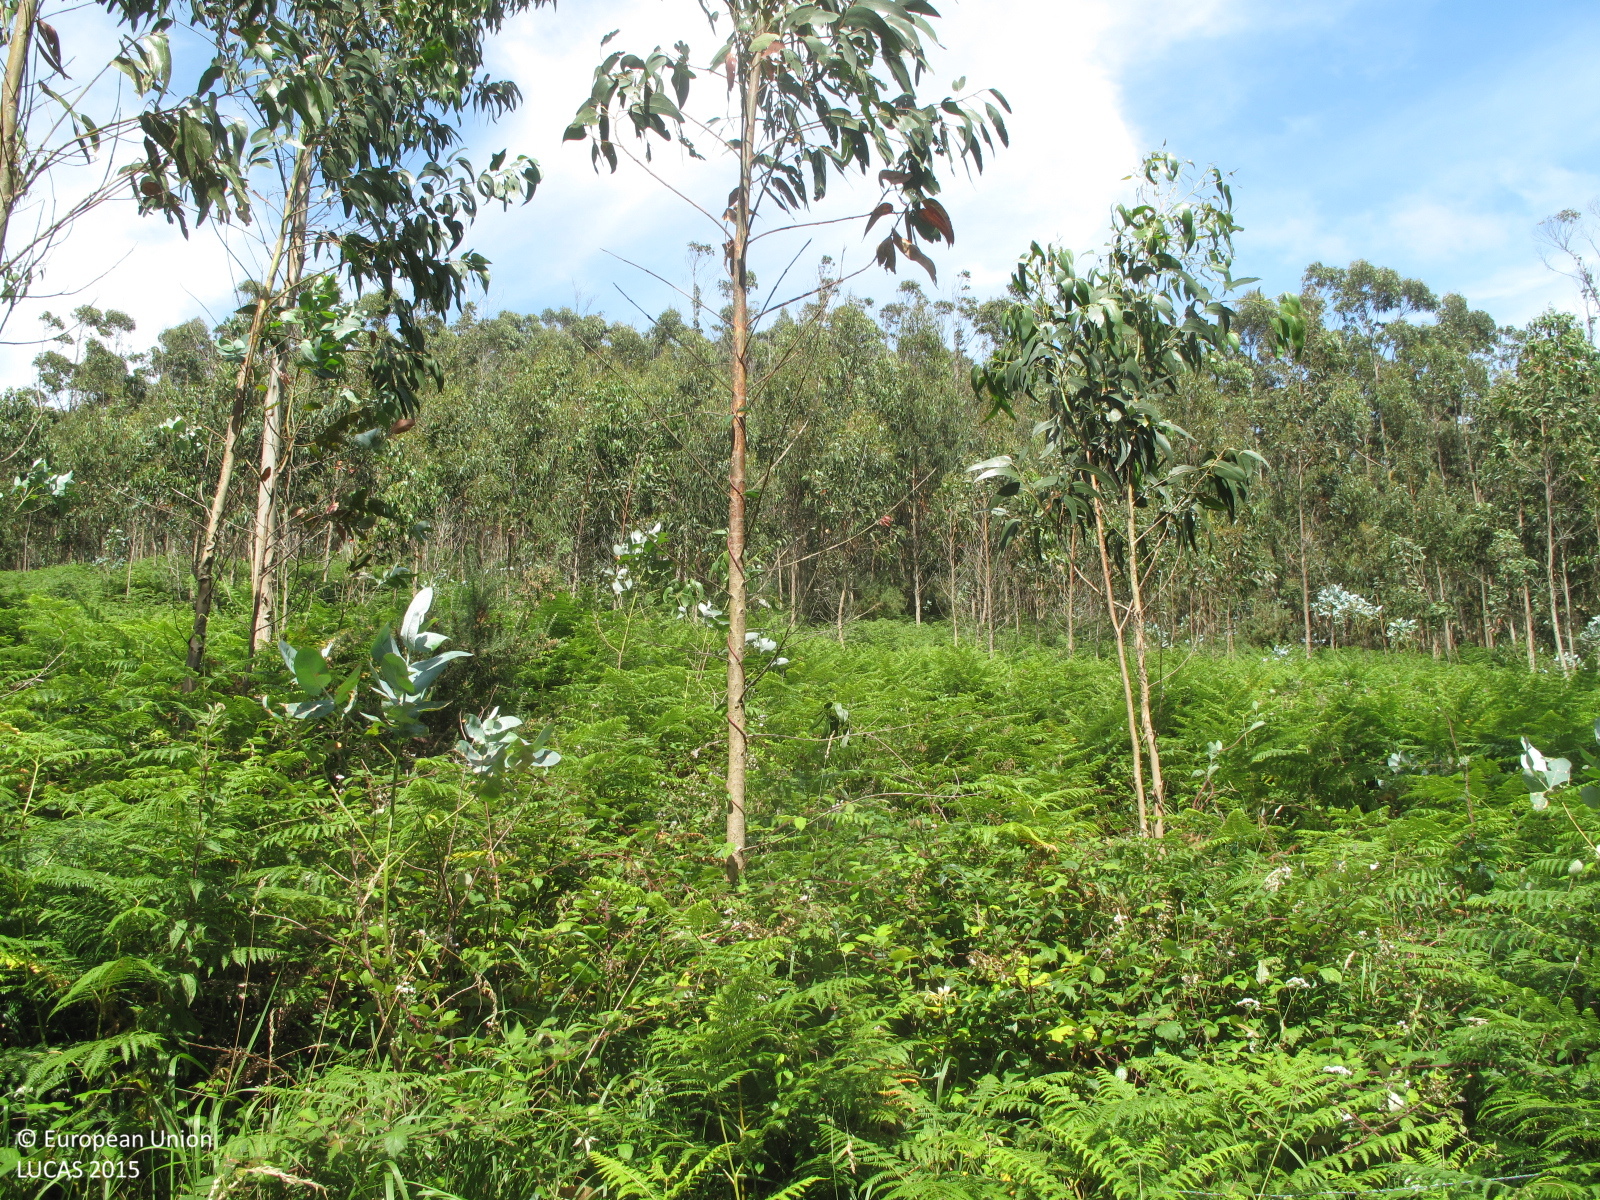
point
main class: Woodland
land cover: Broadleaved woodland
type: exotic forest
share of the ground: 50 - 75 %
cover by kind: broadleaved forest trees 50 %, herbaceous plants 30 %, shrubs 20 %
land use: Forestry
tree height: > 5 m
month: July
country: ES
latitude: 43.6483
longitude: -8.0899
